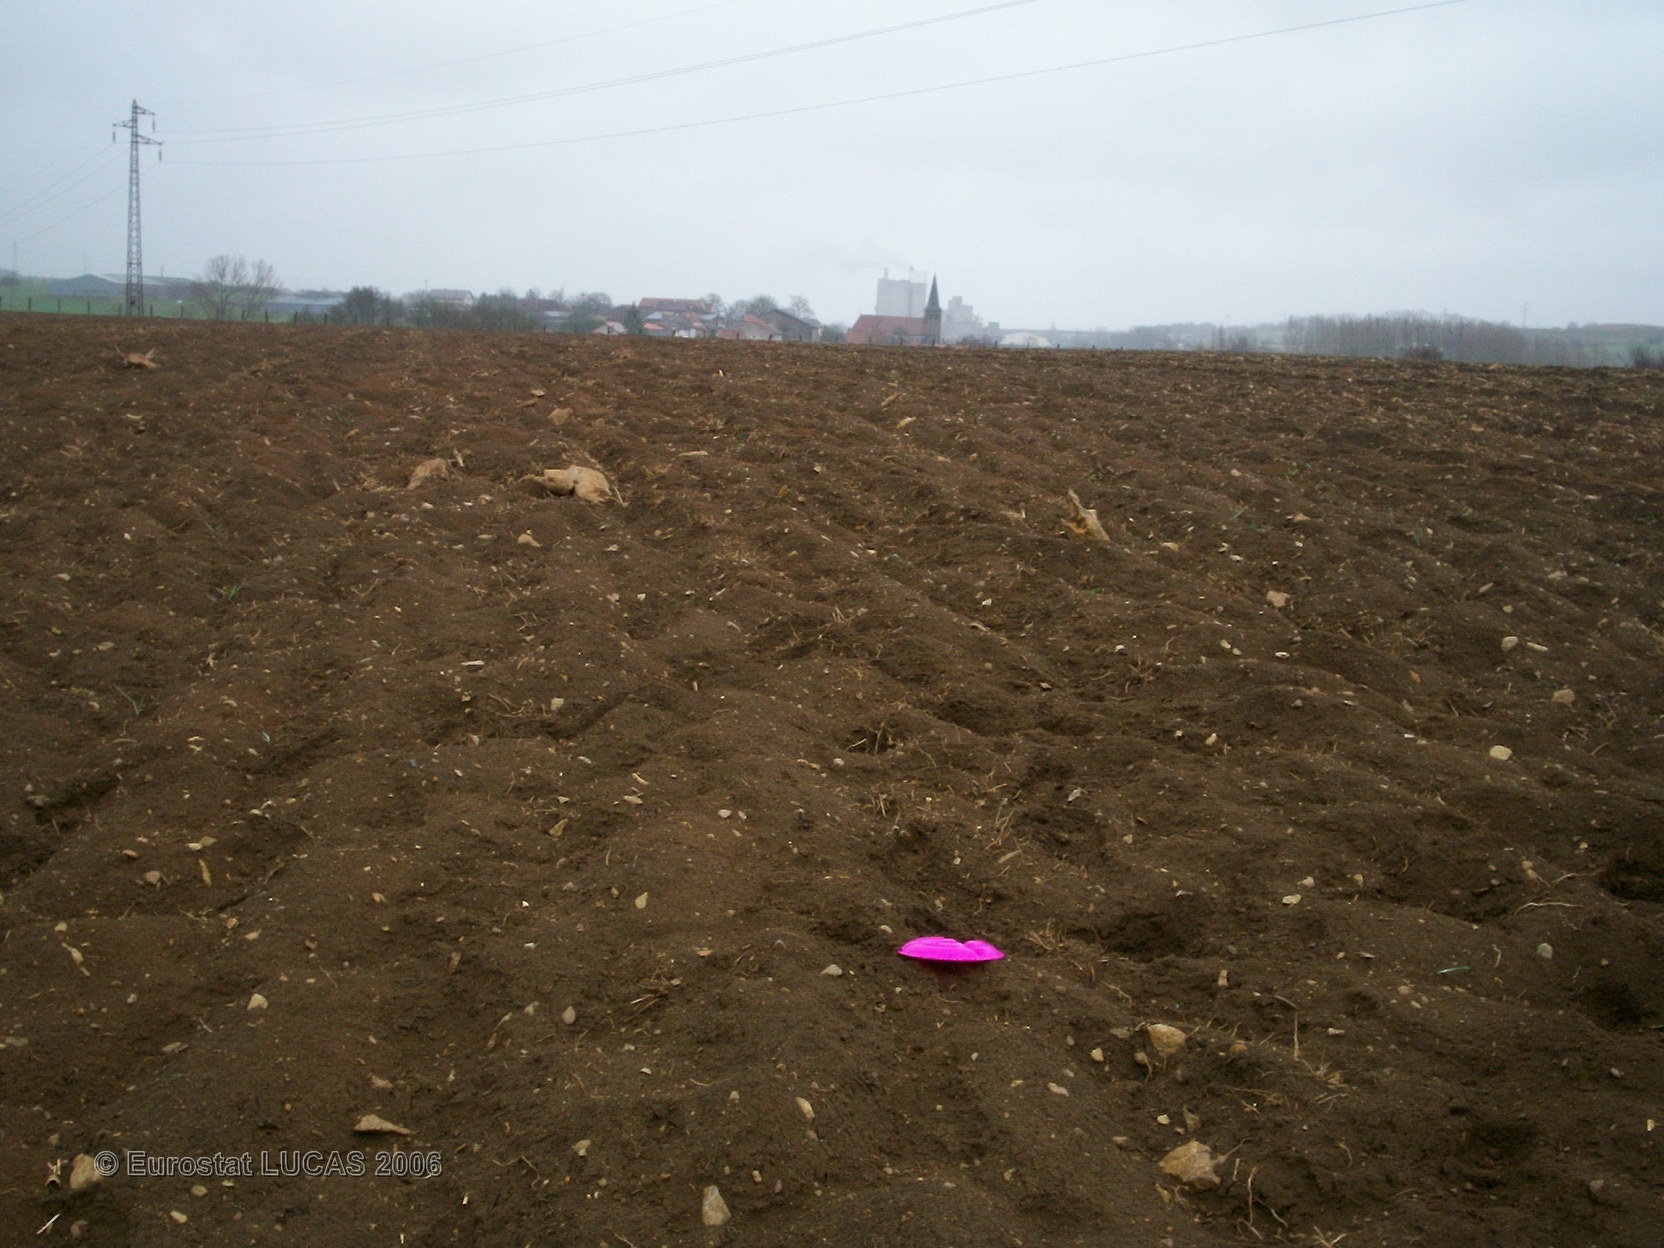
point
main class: Cropland
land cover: Maize
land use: Agriculture (excluding fallow land and kitchen gardens)
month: May
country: FR
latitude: 48.6854
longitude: 6.9443
